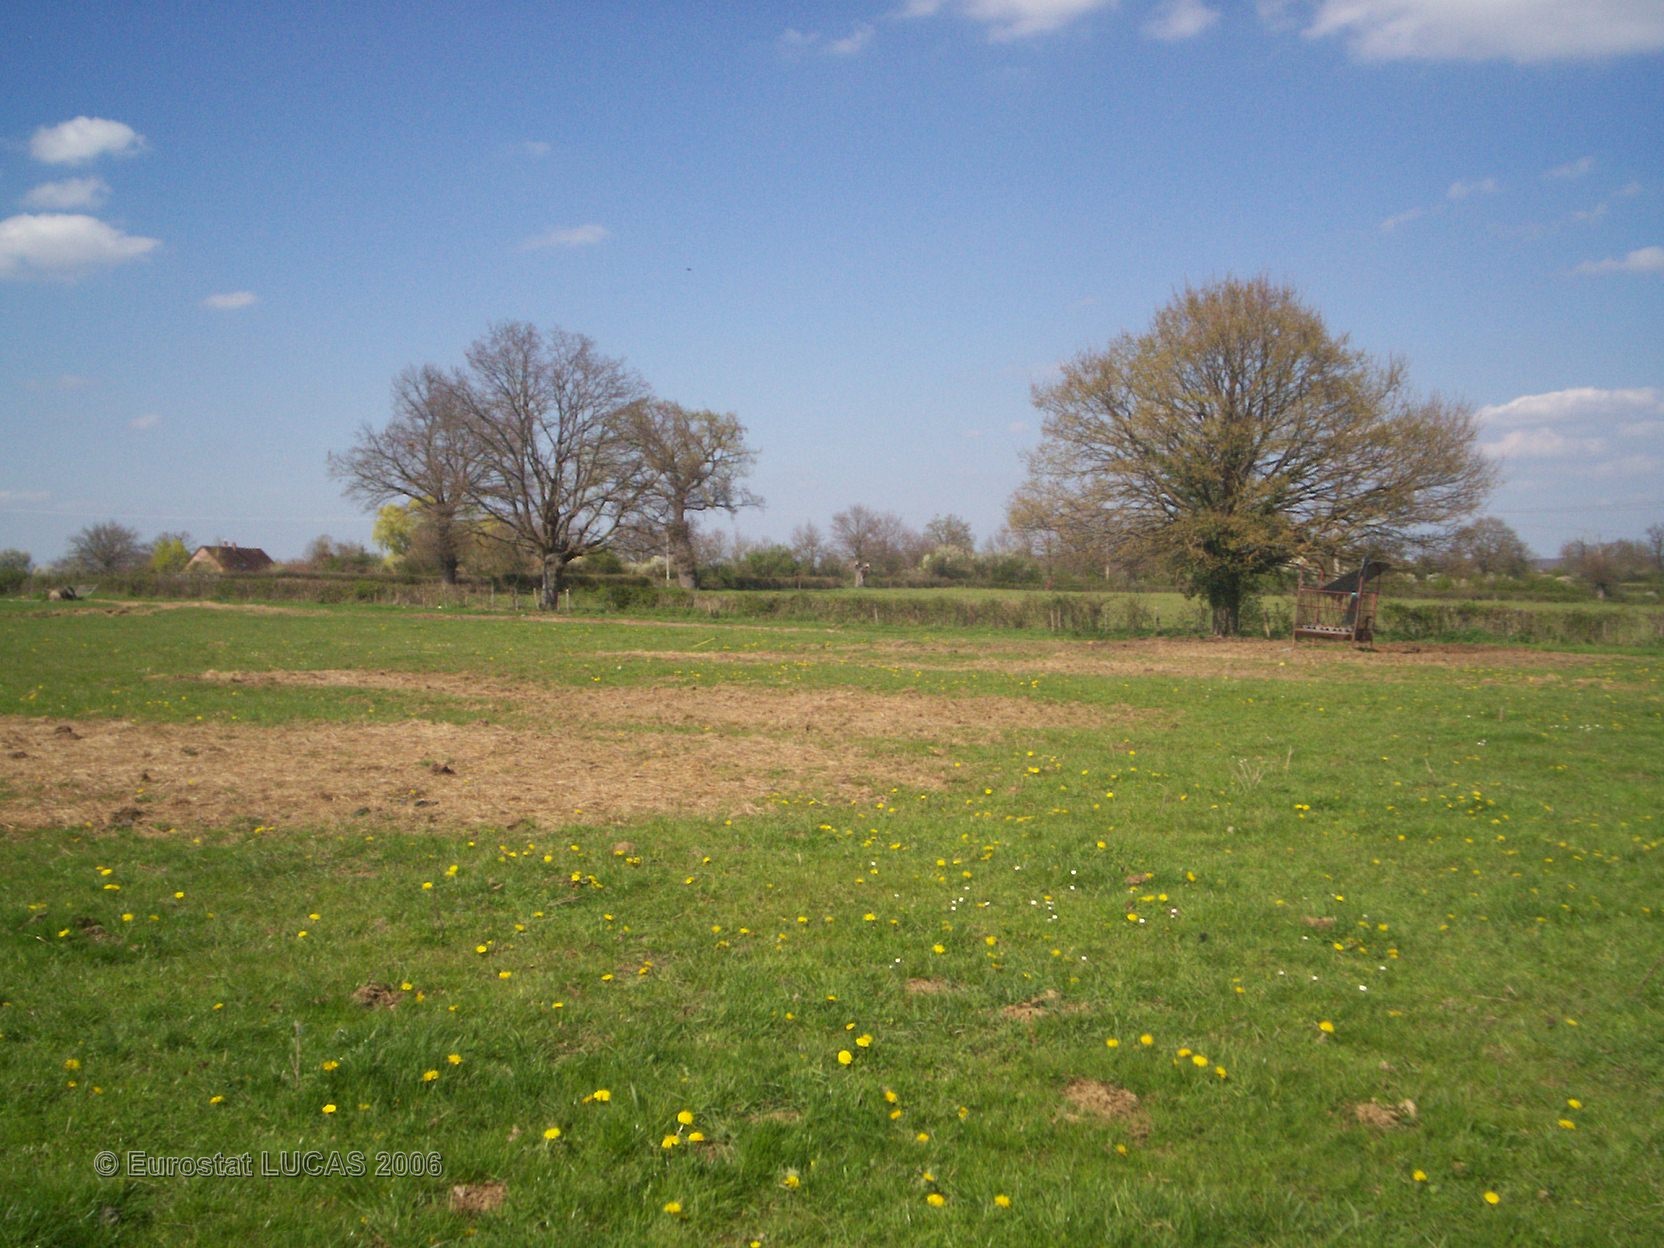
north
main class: Grassland
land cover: Grassland without tree/shrub cover
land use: Agriculture (excluding fallow land and kitchen gardens)
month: April
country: FR
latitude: 46.6189
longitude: 3.1415
